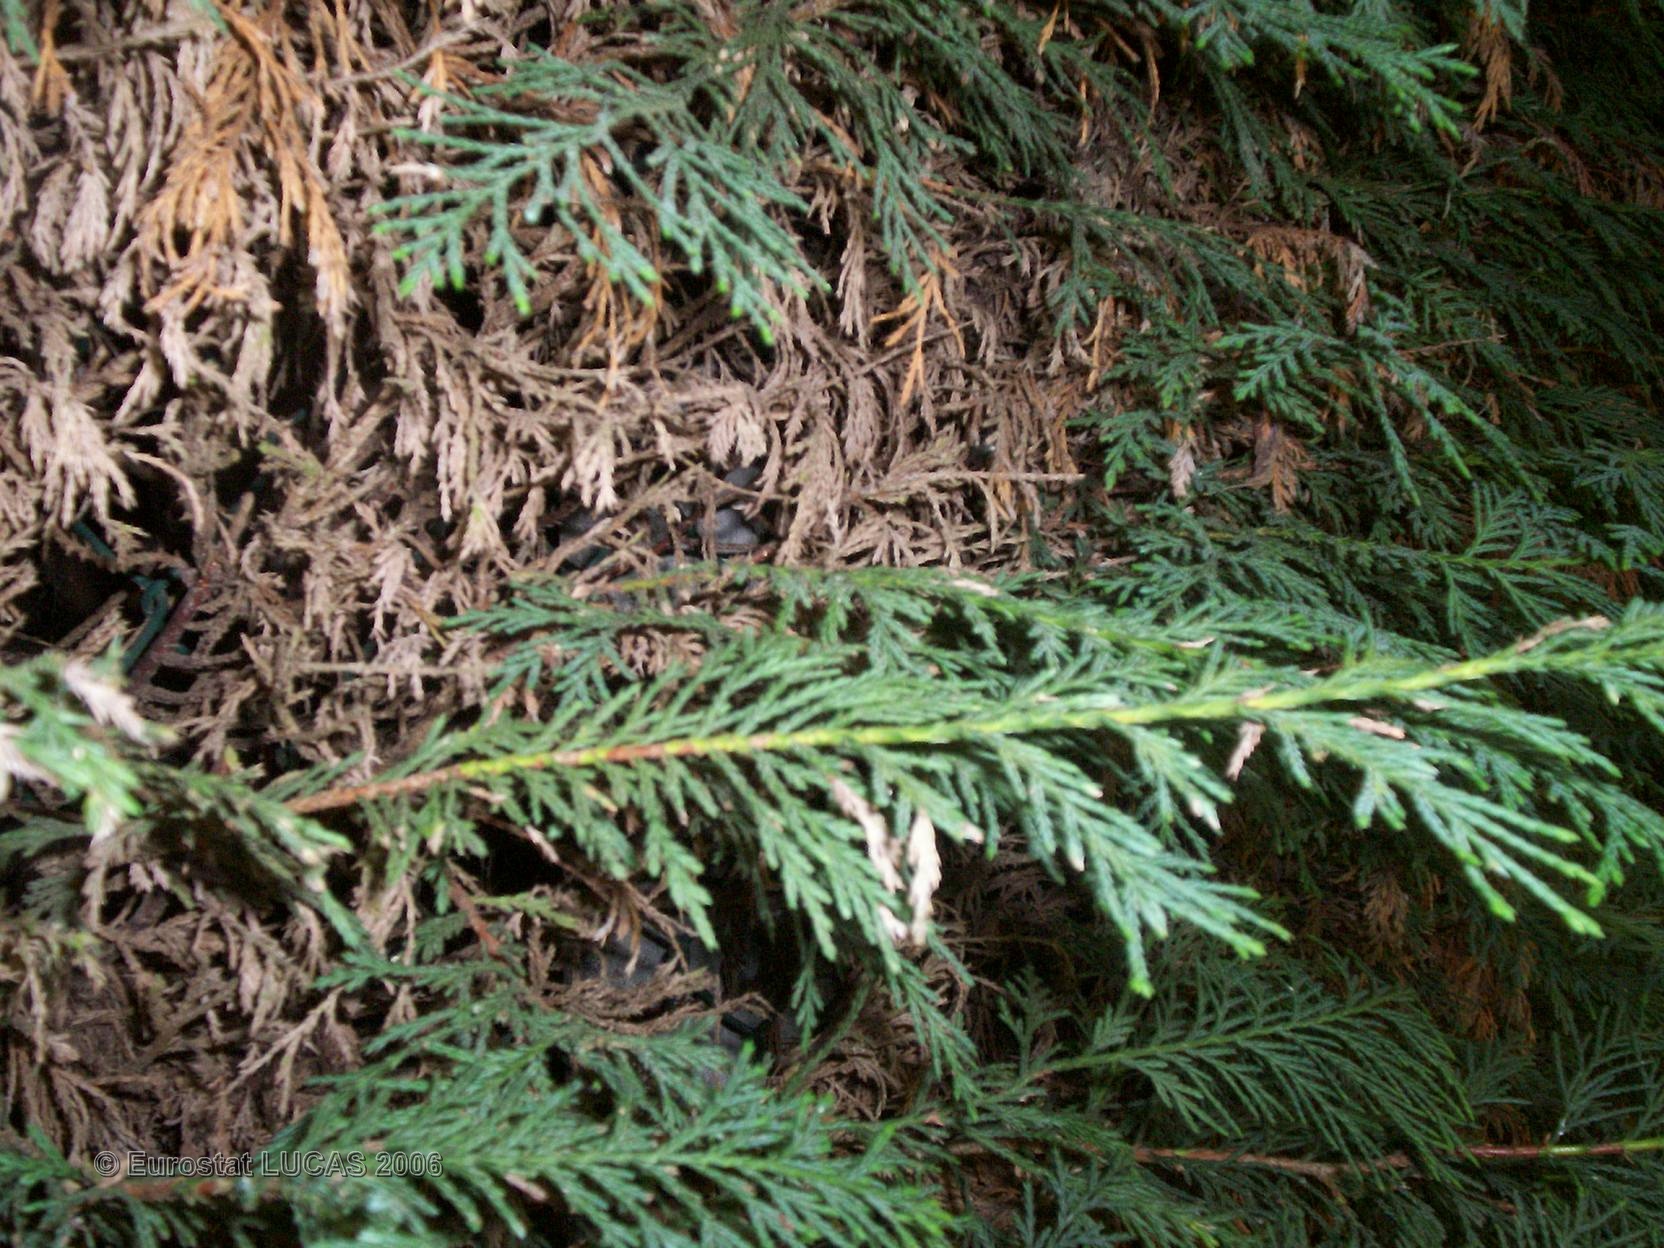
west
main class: Grassland
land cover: Grassland with sparse tree/shrub cover
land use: Residential
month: June
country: FR
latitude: 49.7498
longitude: 2.6745
